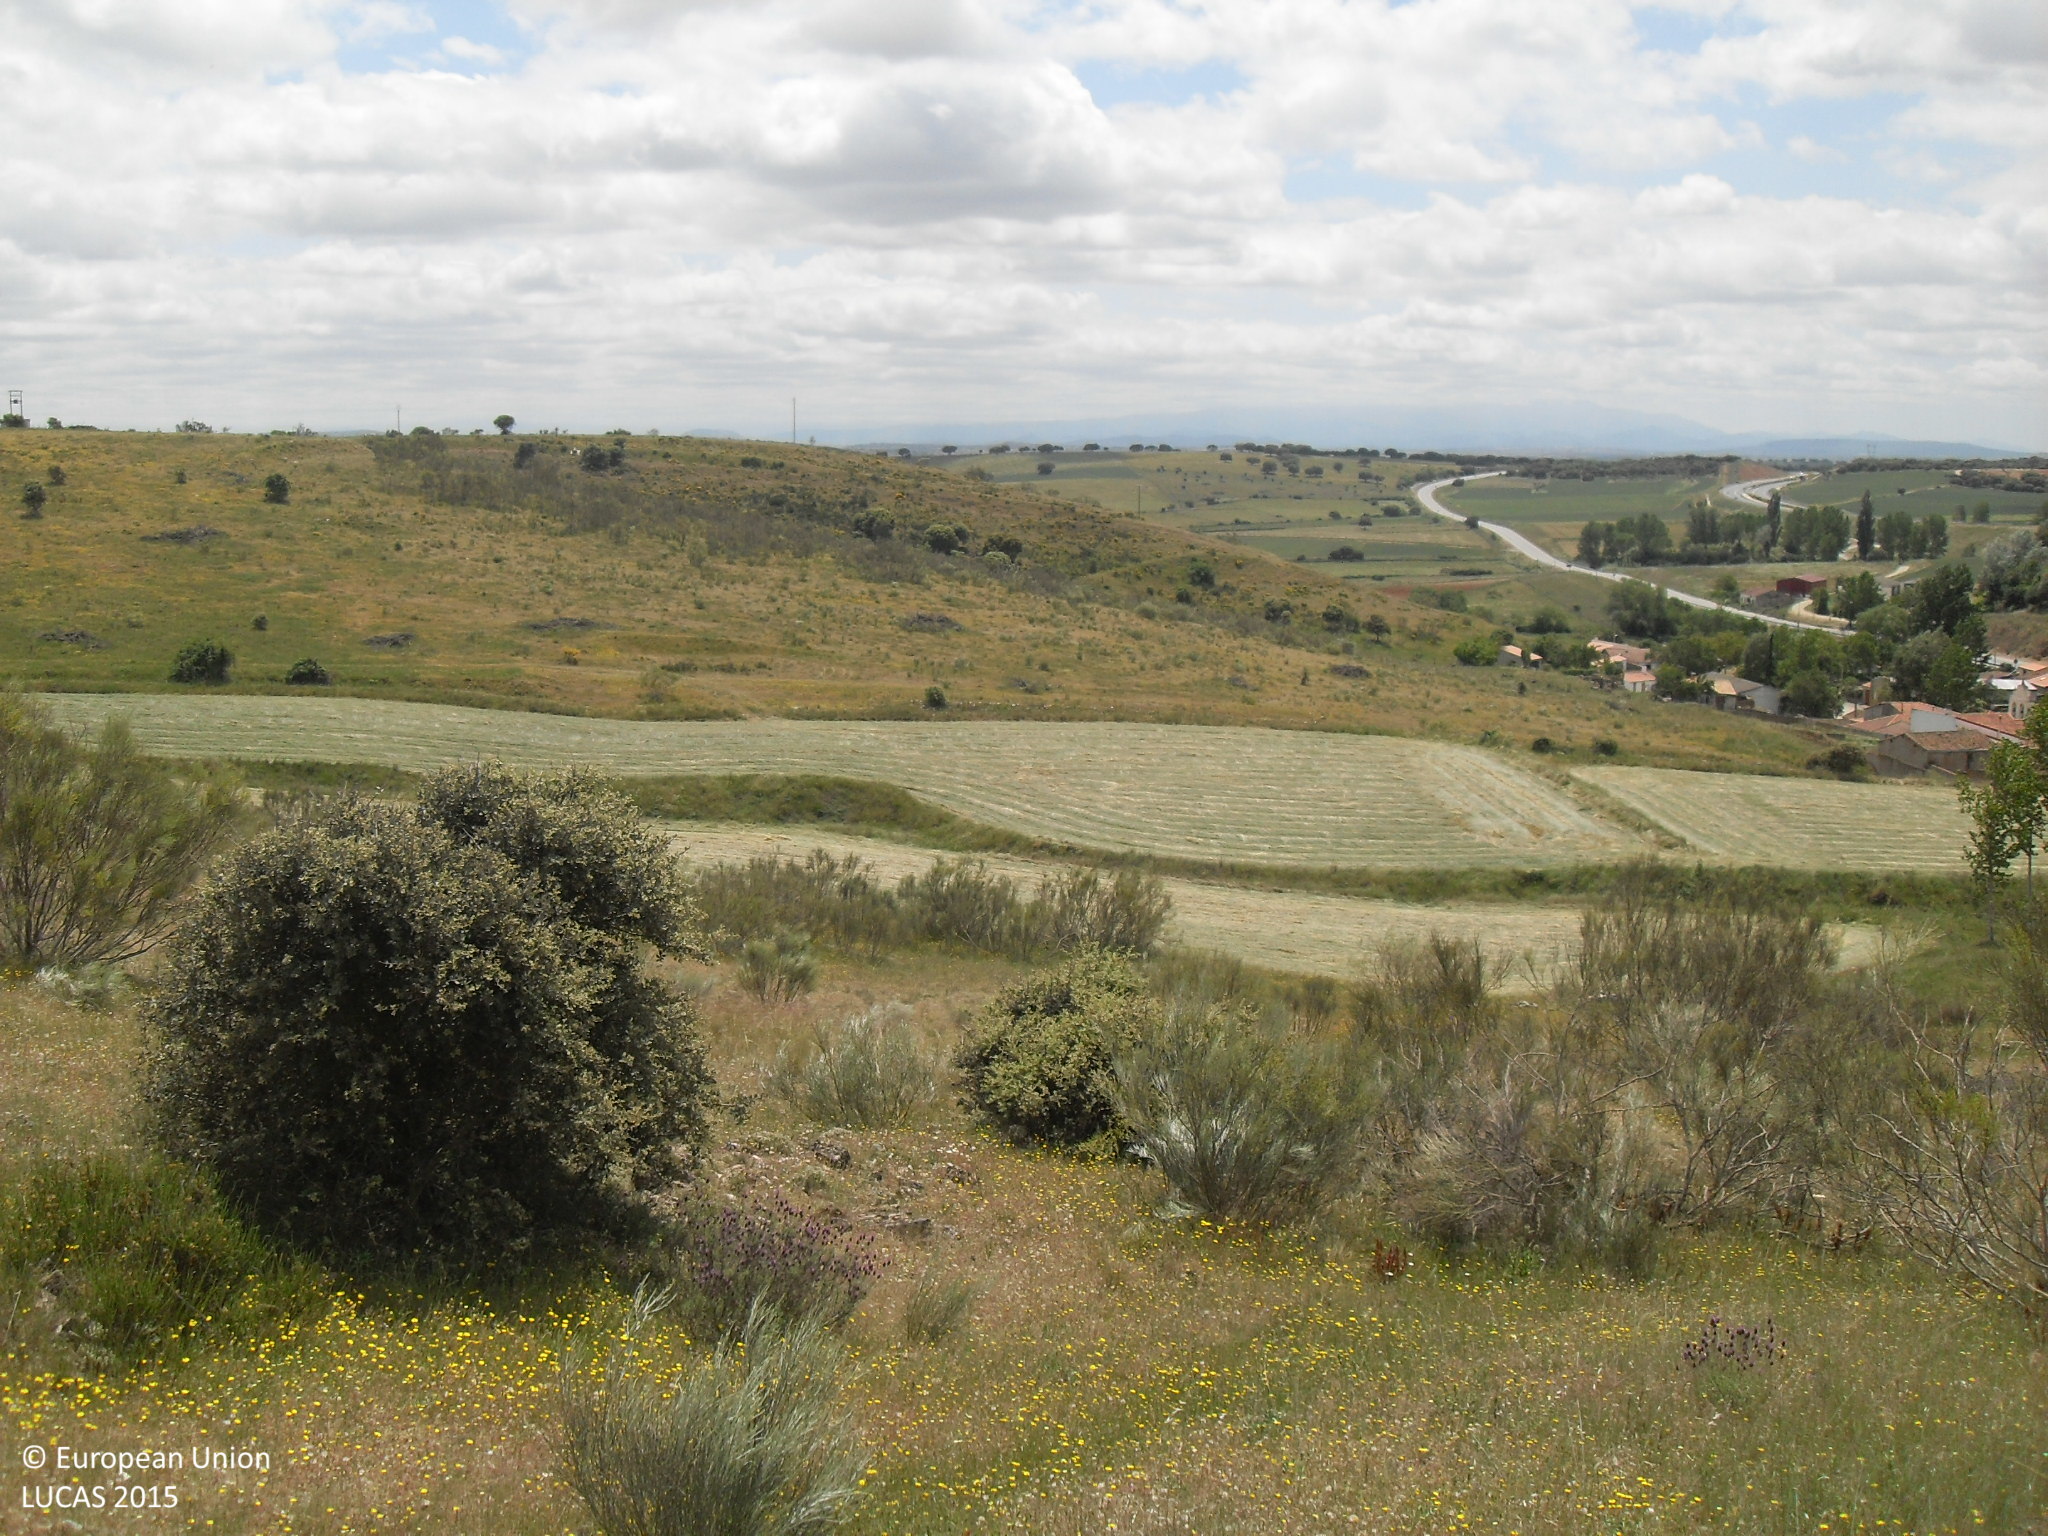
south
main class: Shrubland
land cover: Shrubland without tree cover
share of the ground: 10 - 25 %
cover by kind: herbaceous plants 80 %, shrubs 20 %
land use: Agriculture (excluding fallow land and kitchen gardens)
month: May
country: ES
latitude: 40.7531
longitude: -5.6251
